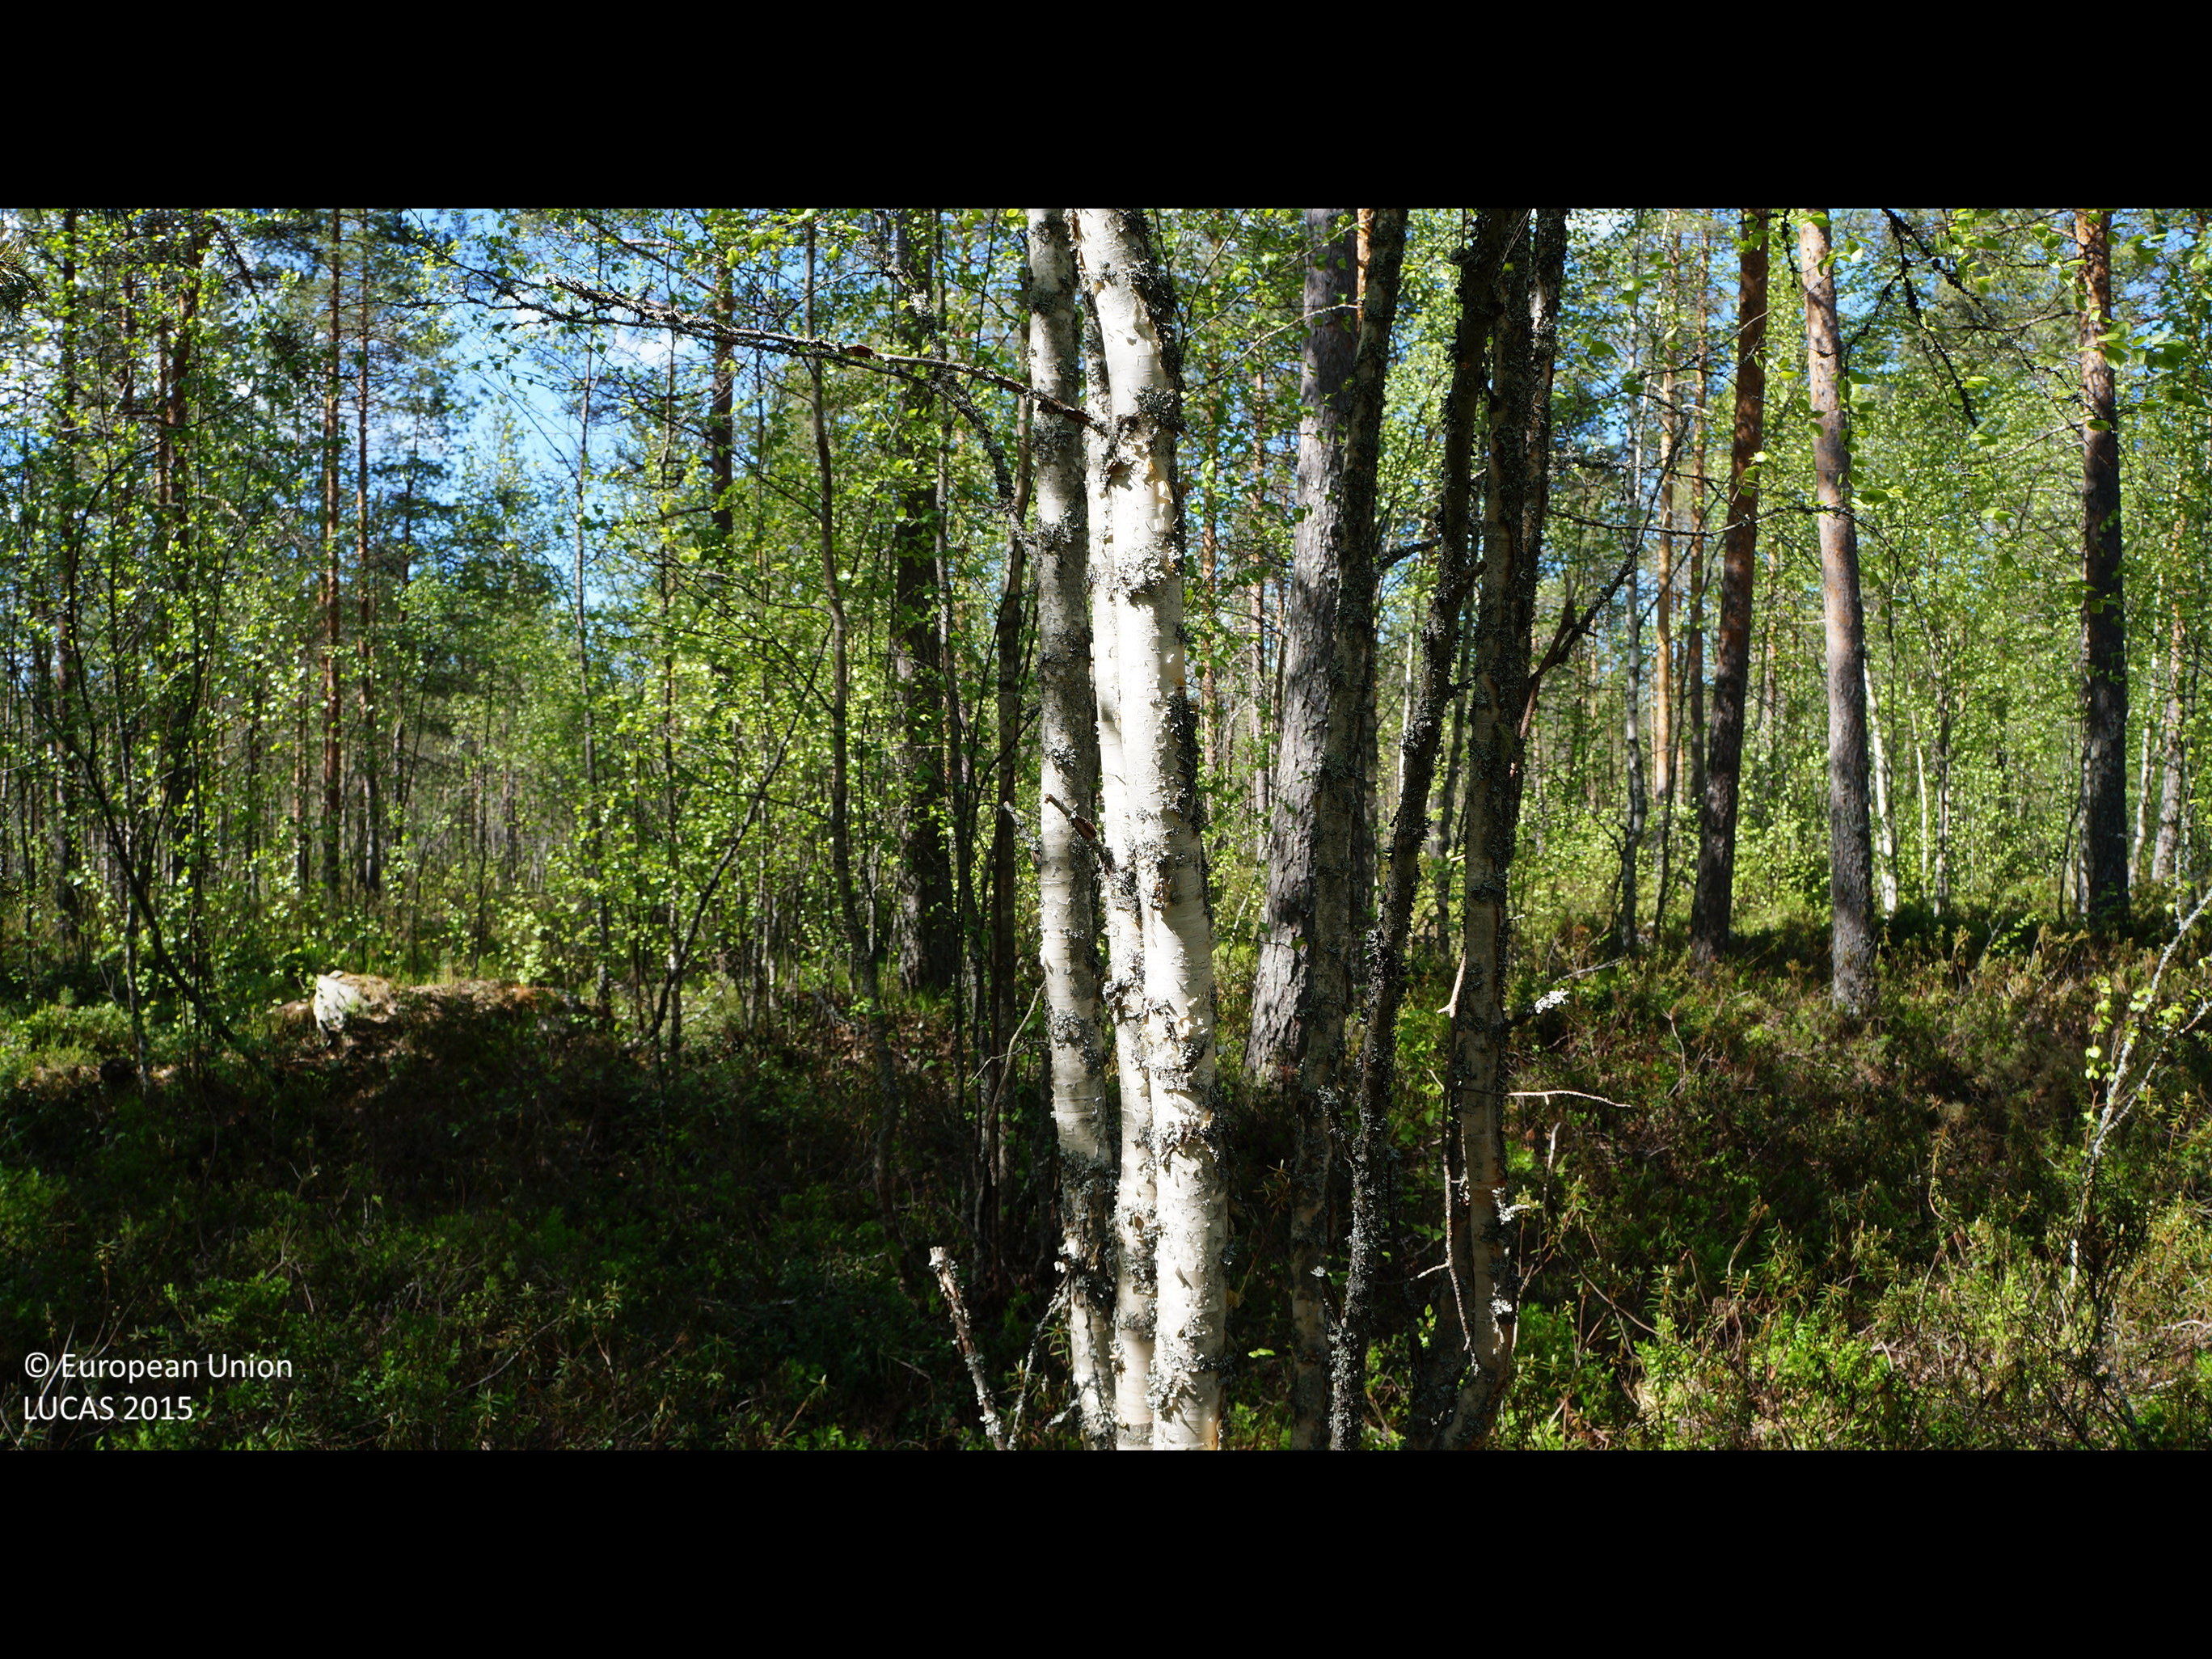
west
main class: Woodland
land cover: Pine dominated mixed woodland
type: boreal forest
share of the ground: > 75 %
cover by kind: coniferous forest trees 65 %, broadleaved forest trees 25 %, shrubs 10 %
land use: Forestry
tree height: > 5 m
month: June
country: FI
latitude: 63.7800
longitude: 23.3032
